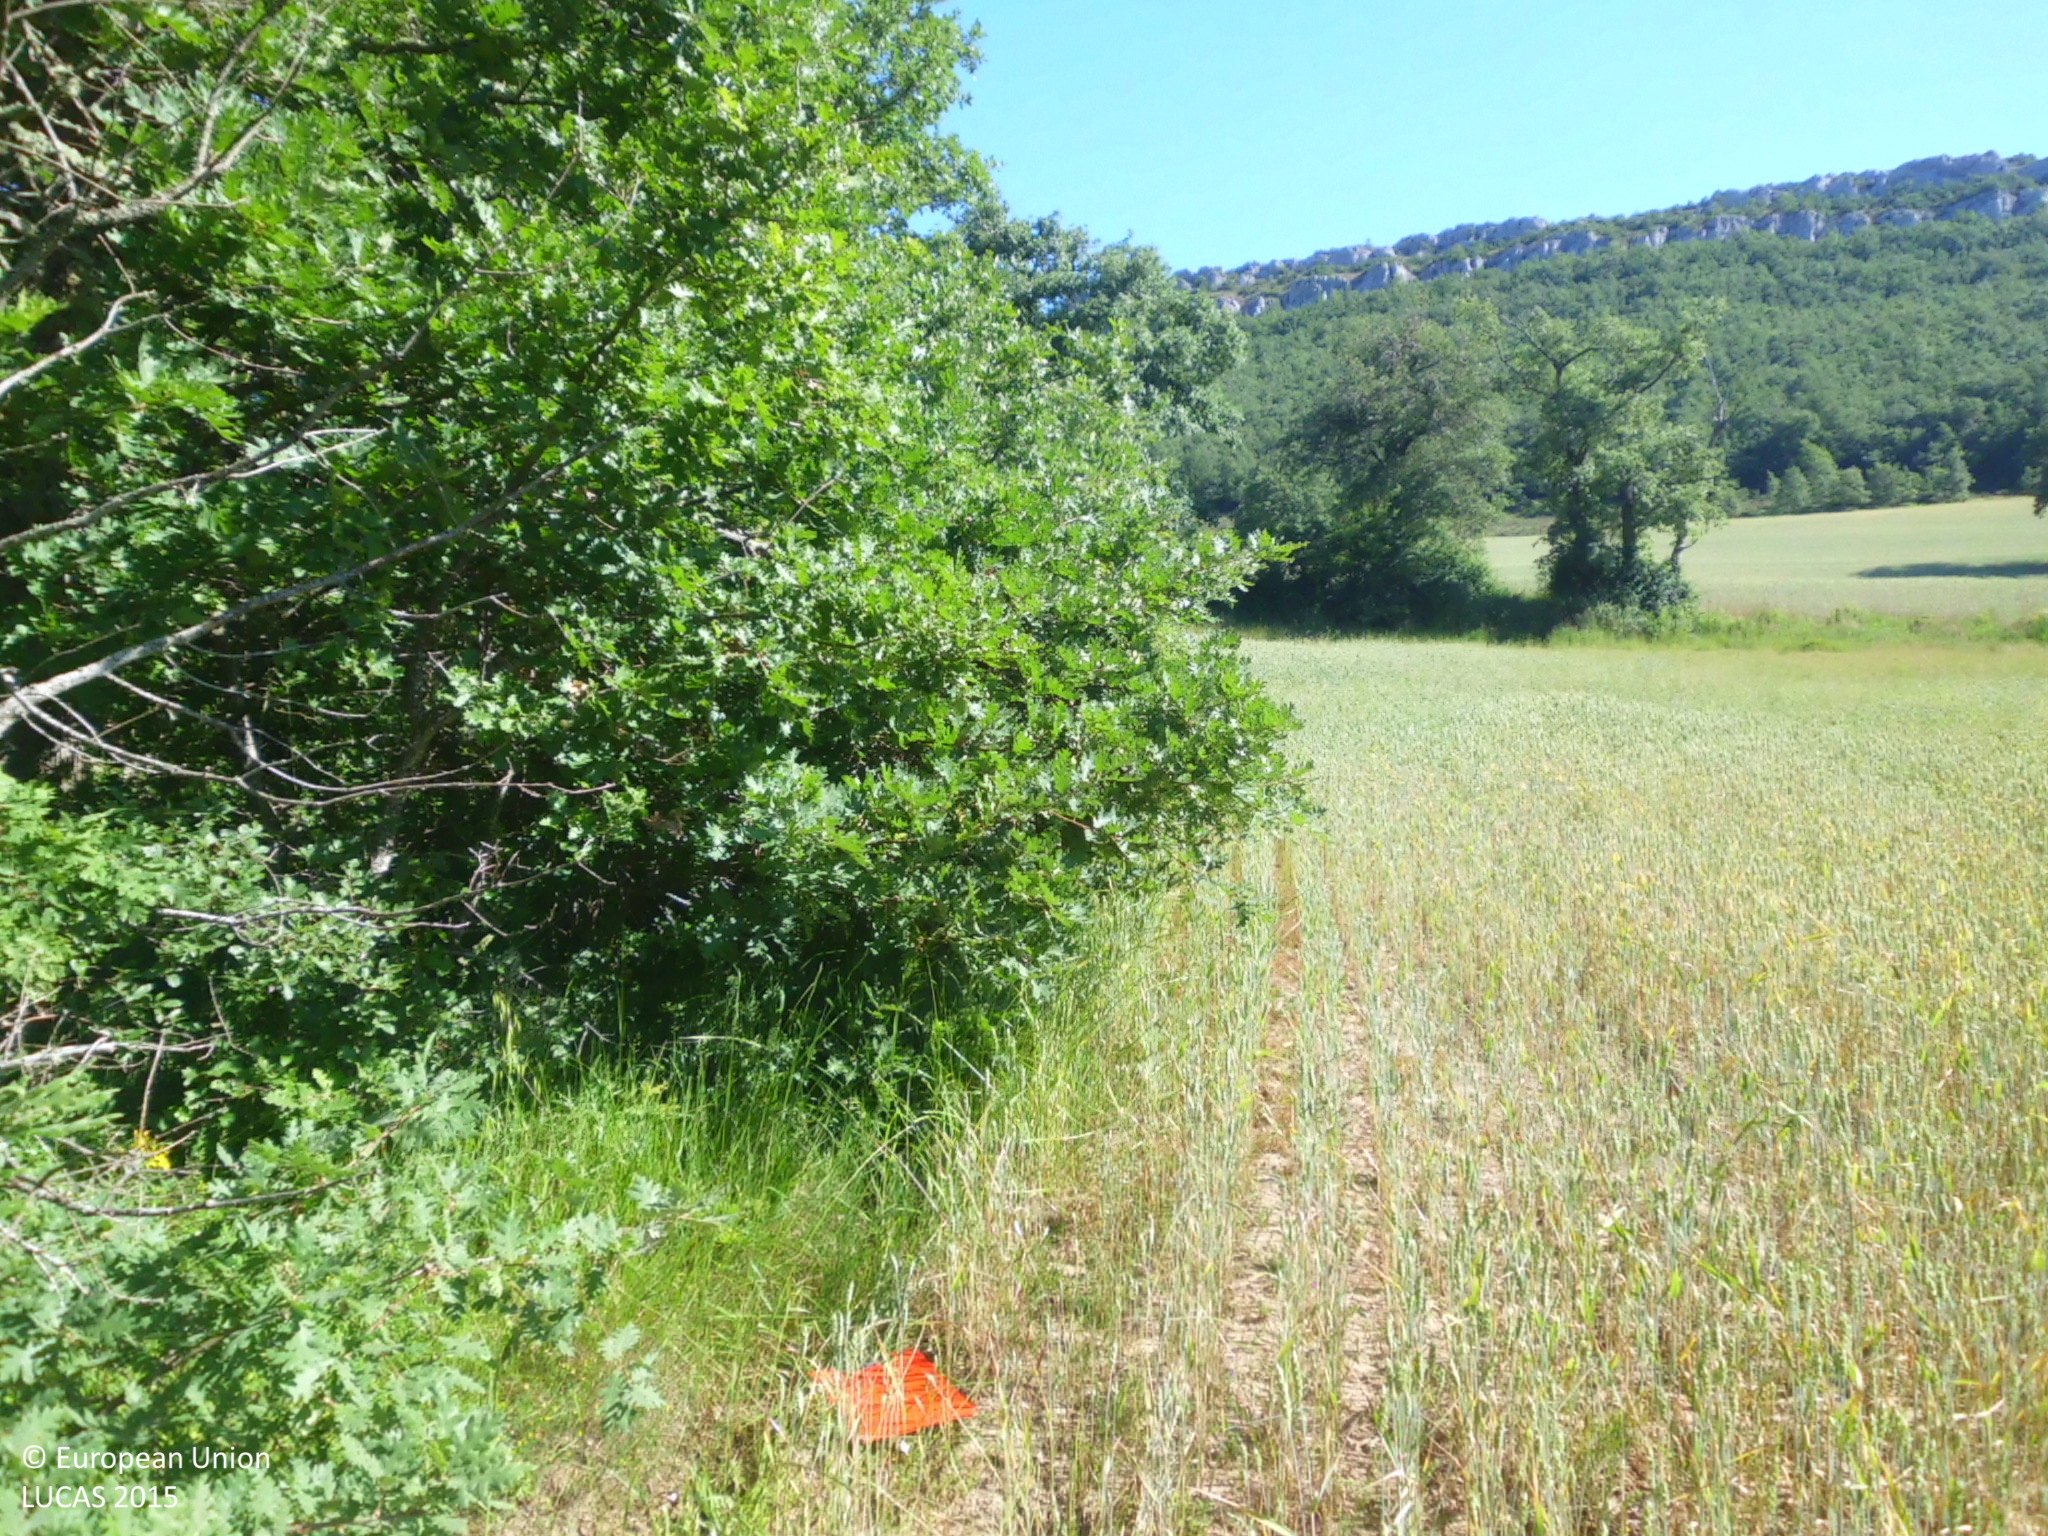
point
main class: Woodland
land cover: Broadleaved woodland
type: acidophilous oak and oak-birch forest
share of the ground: 50 - 75 %
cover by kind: broadleaved forest trees 50 %, herbaceous plants 50 %
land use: Forestry
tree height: > 5 m
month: June
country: ES
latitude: 42.6735
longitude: -4.0660
